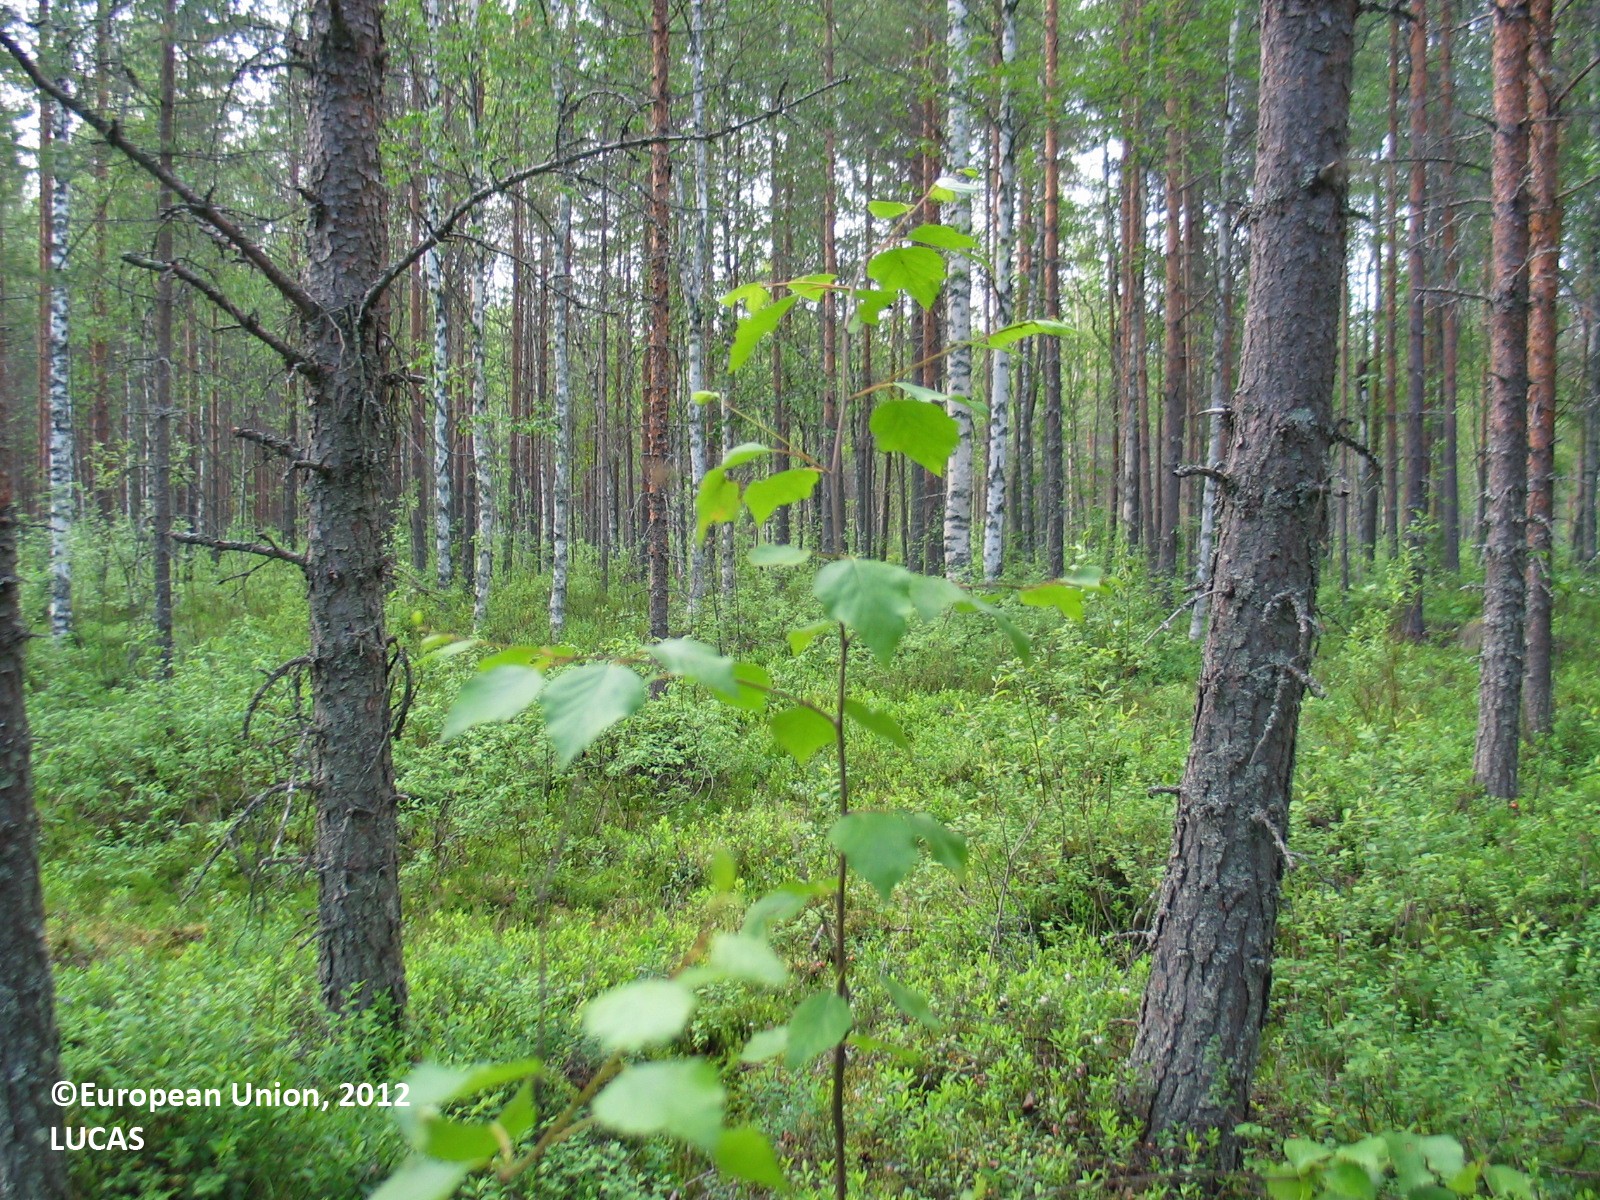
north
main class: Woodland
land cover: Pine dominated mixed woodland
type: mire and swamp forests
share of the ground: 50 - 75 %
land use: Forestry
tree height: > 5 m
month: July
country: FI
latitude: 64.4505
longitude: 26.3409
